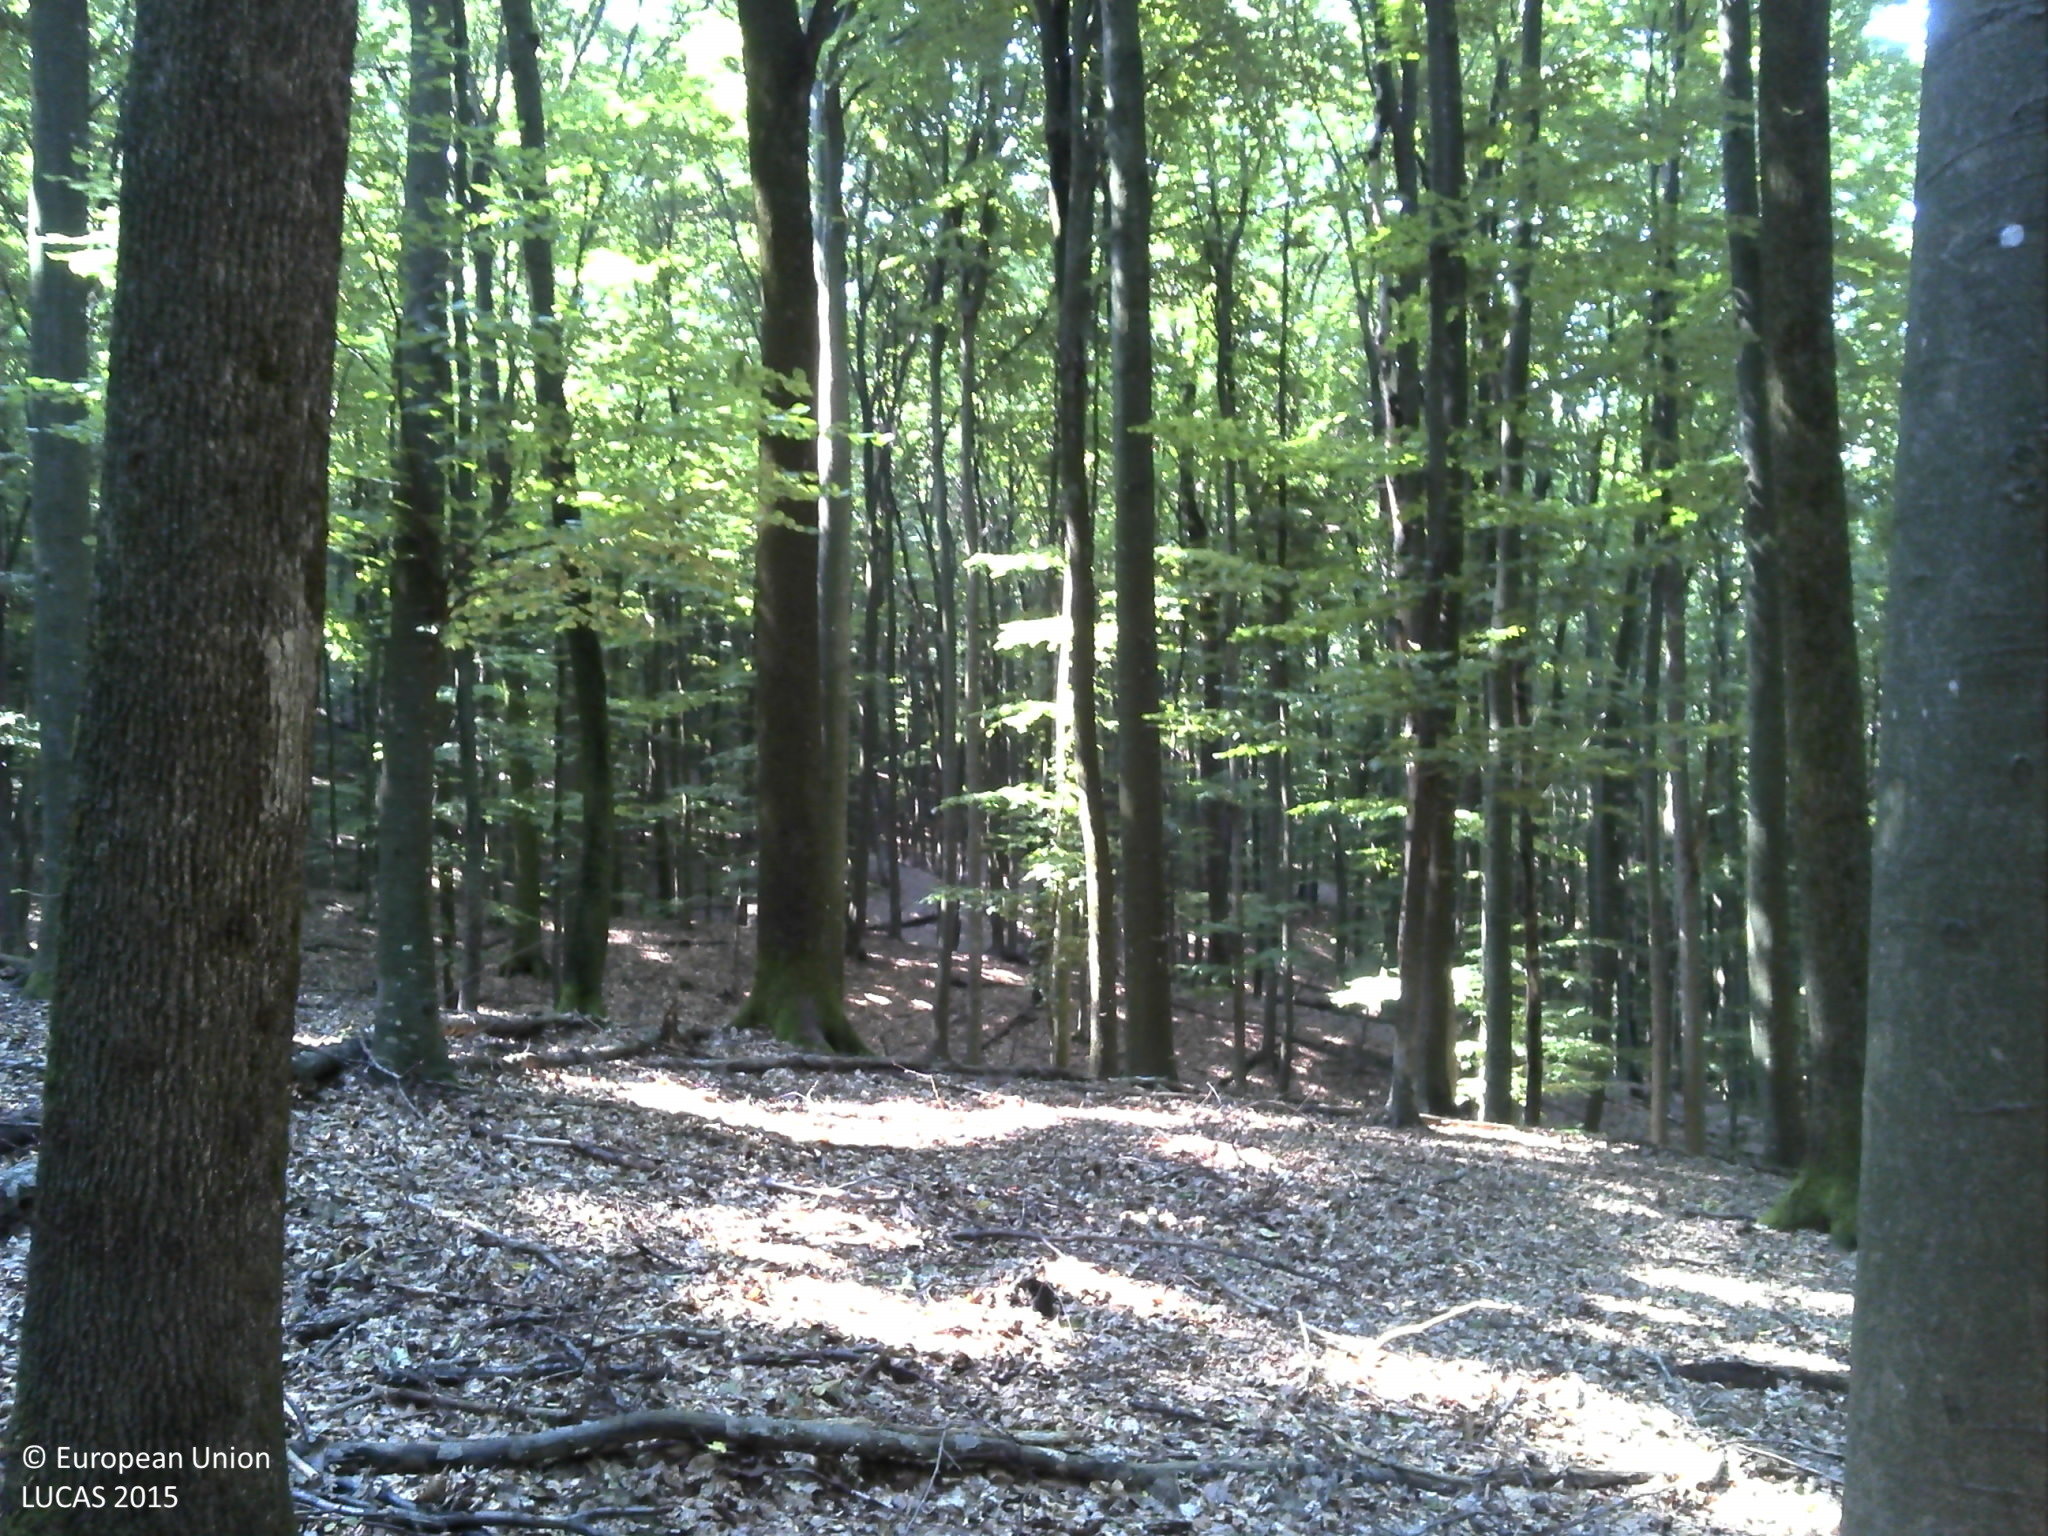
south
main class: Woodland
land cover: Broadleaved woodland
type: acidophilous oak and oak-birch forest
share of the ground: > 75 %
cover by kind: broadleaved forest trees 80 %, lichens and mosses 20 %
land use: Forestry
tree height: > 5 m
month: July
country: HR
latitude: 45.5790
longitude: 16.7273
